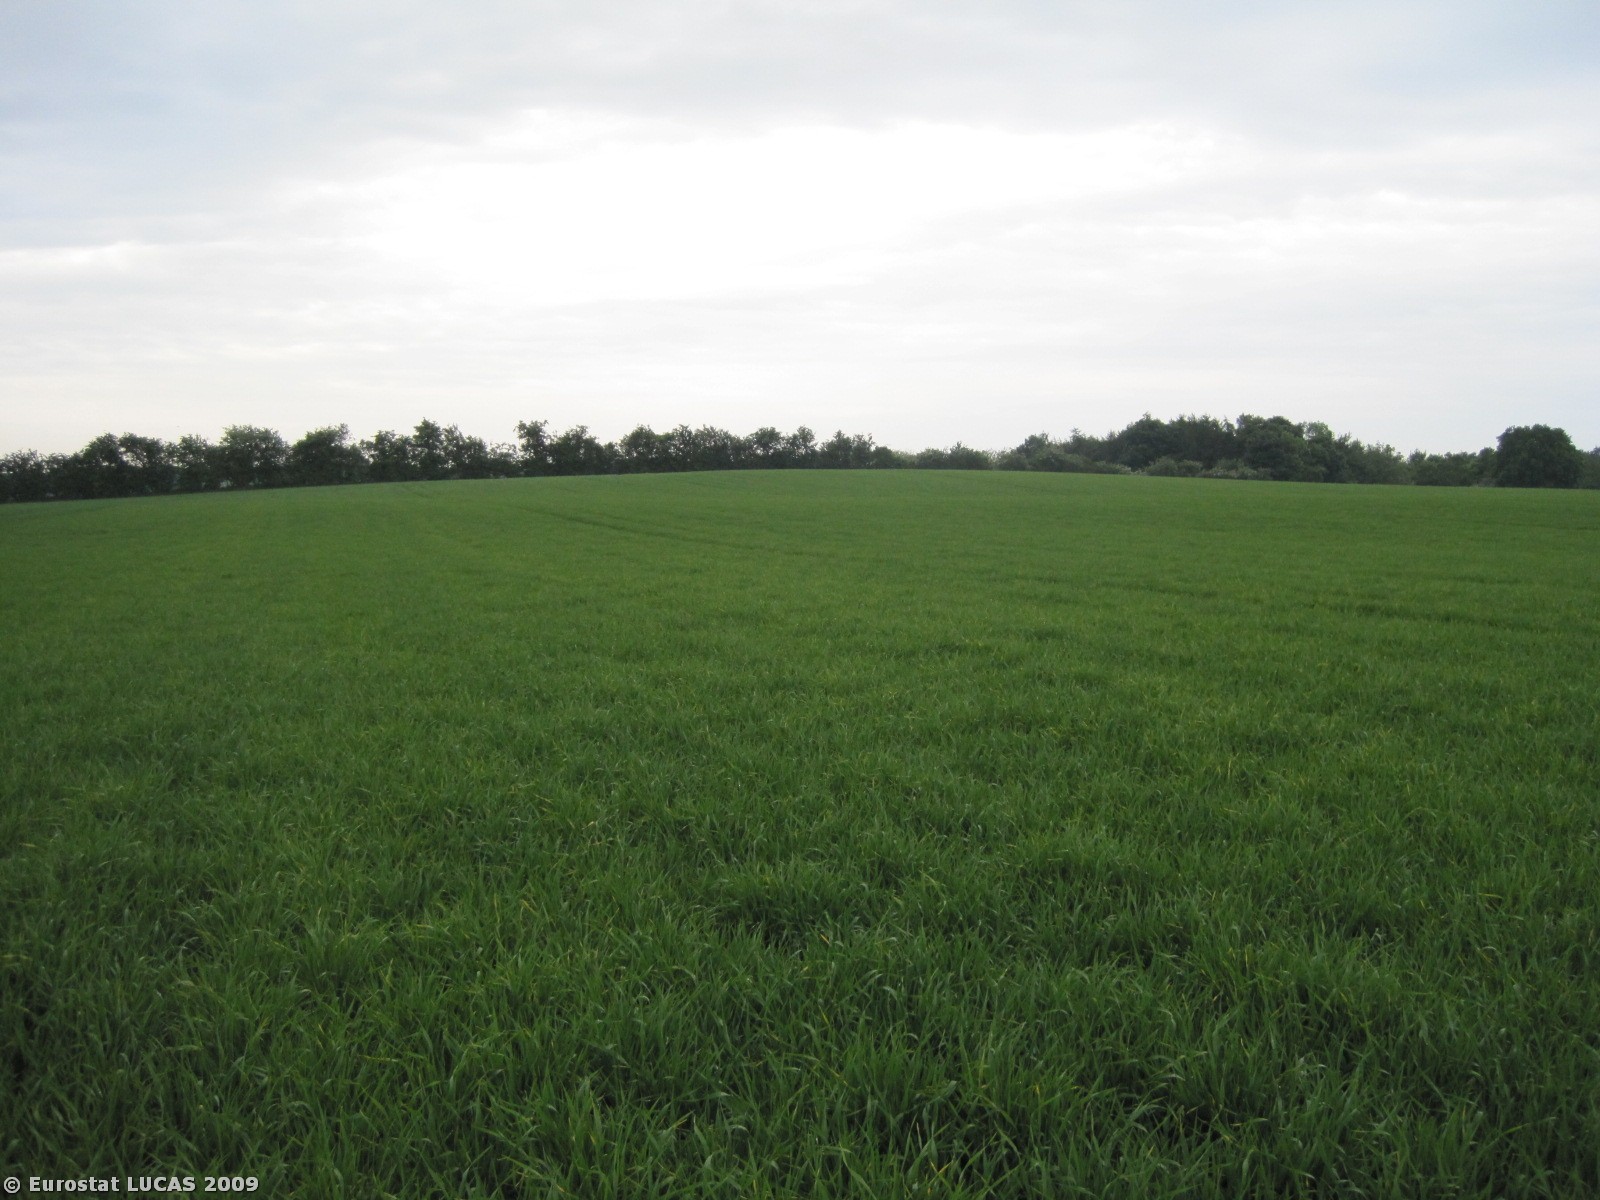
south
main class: Cropland
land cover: Barley
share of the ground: > 75 %
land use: Agriculture (excluding fallow land and kitchen gardens)
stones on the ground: < 10 %
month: May
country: DK
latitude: 56.4034
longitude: 9.9838
